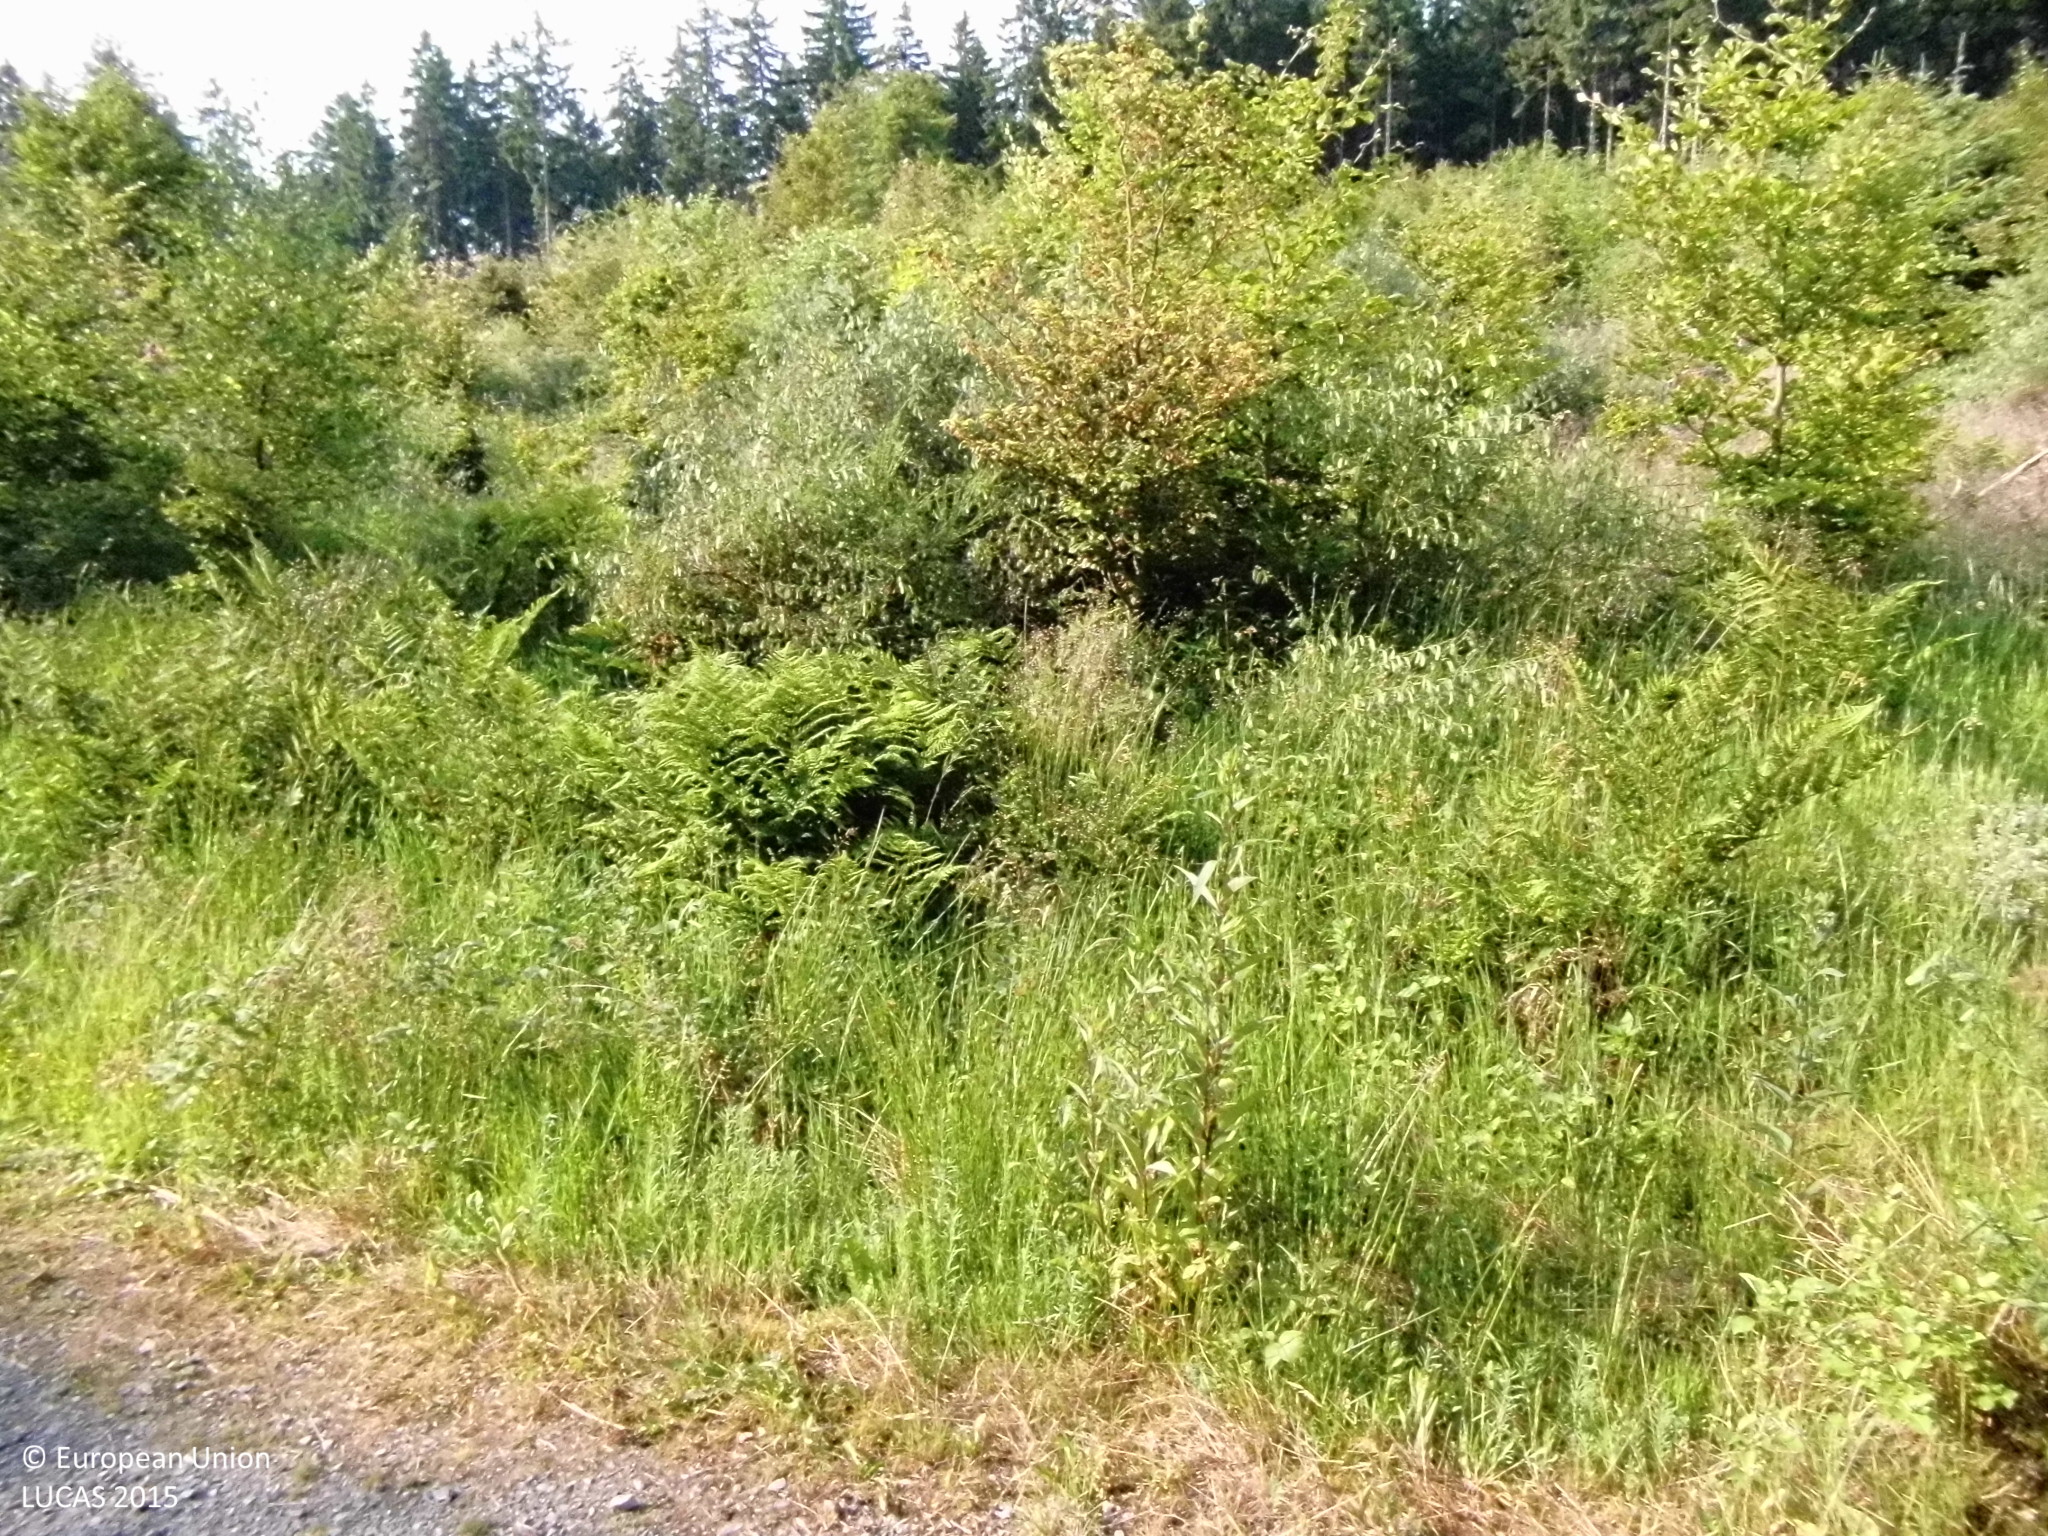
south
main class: Woodland
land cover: Broadleaved woodland
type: mesophytic deciduous forest
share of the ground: > 75 %
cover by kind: broadleaved forest trees 100 %
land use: Forestry
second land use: Amenities, museums, leisure
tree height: > 5 m
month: July
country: DE
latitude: 51.2639
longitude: 8.0083
